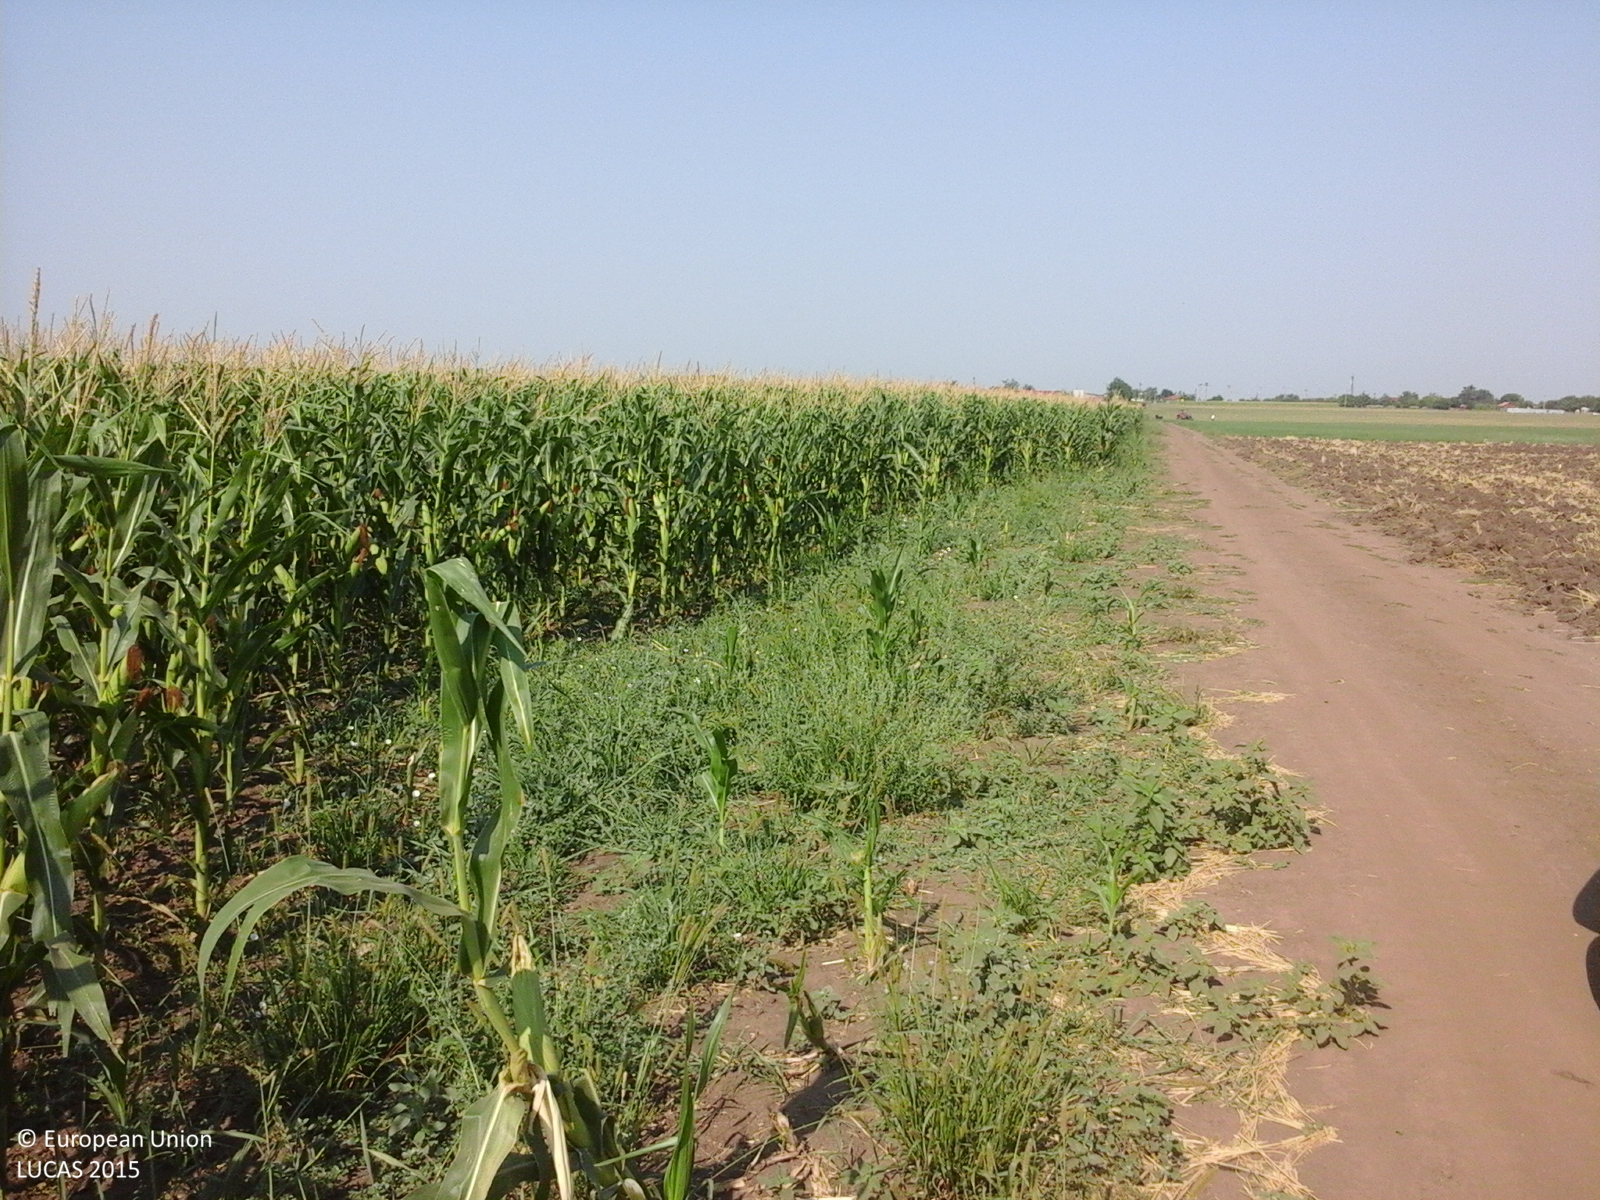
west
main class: Cropland
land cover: Maize
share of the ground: > 75 %
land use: Agriculture (excluding fallow land and kitchen gardens)
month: July
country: RO
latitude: 45.7262
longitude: 27.9132
